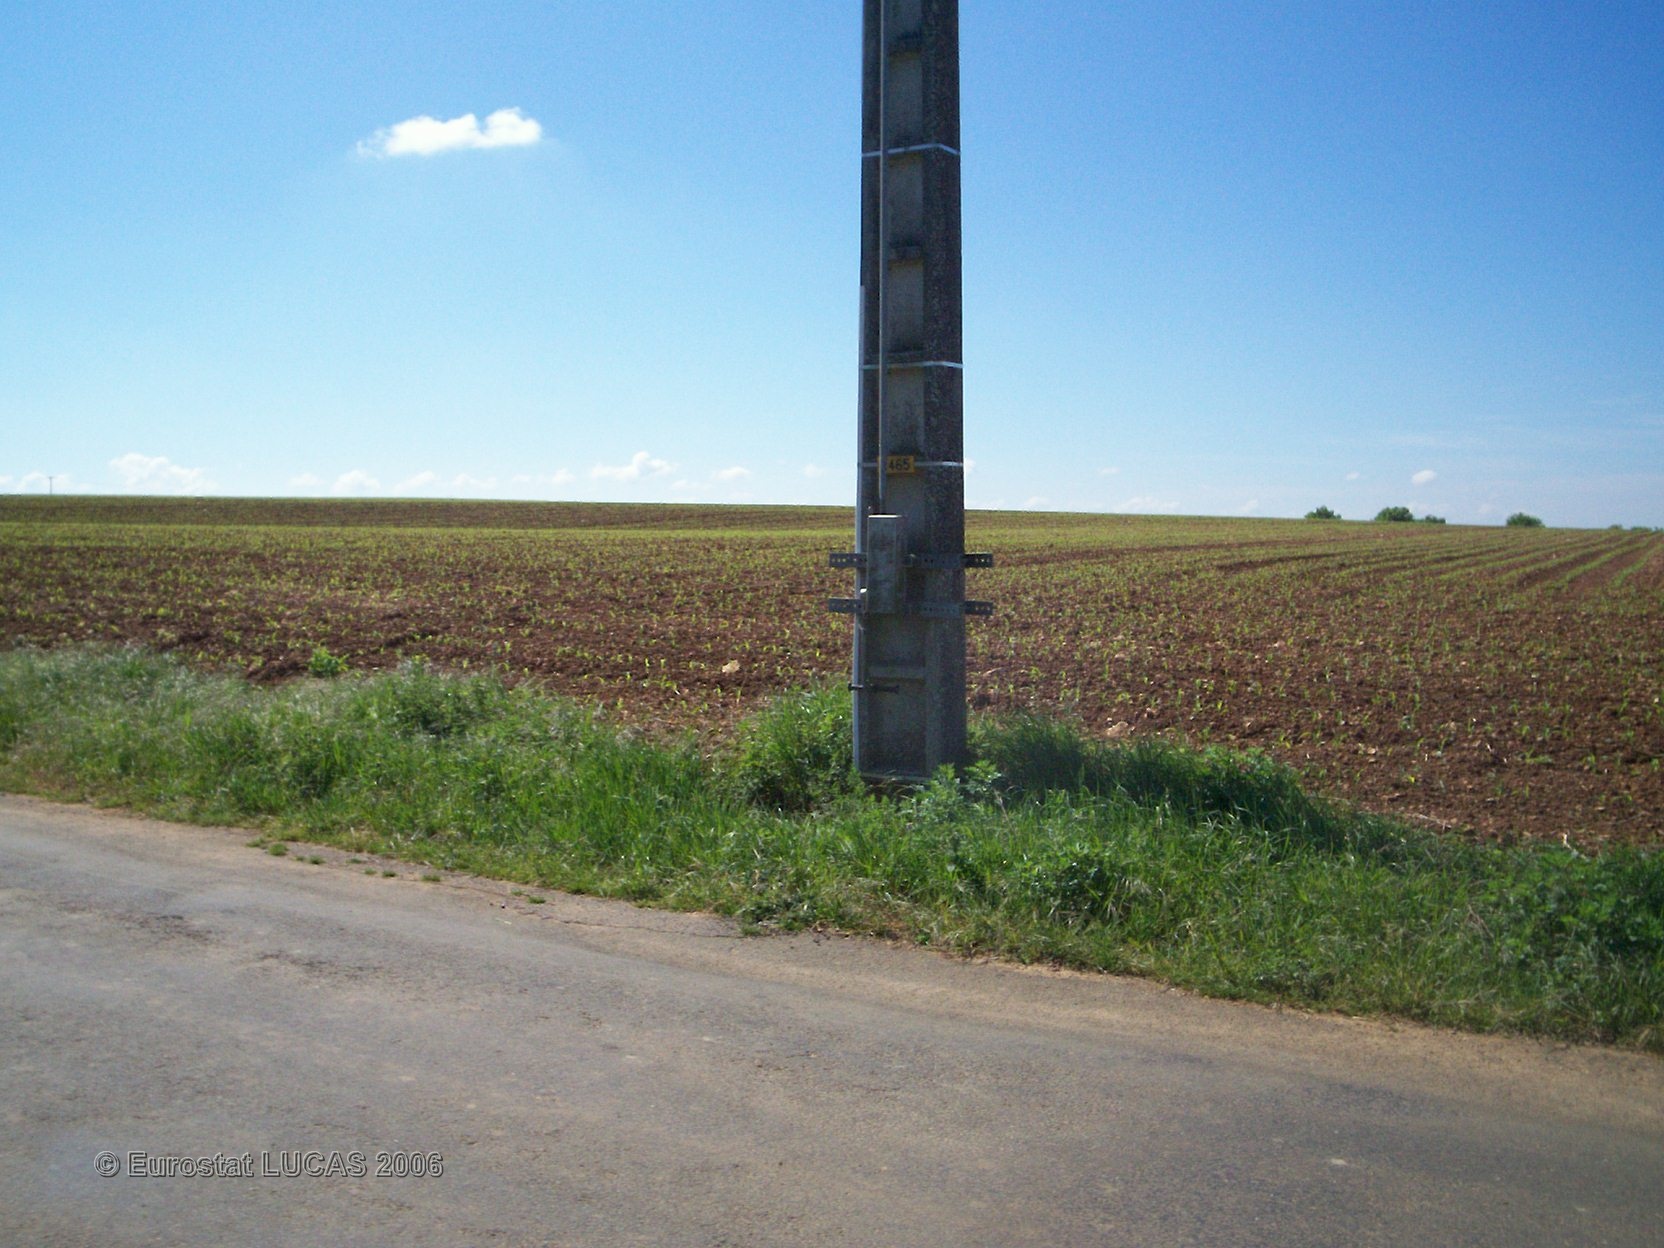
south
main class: Cropland
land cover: Common wheat
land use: Agriculture (excluding fallow land and kitchen gardens)
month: May
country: FR
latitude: 46.5452
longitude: -0.9996
